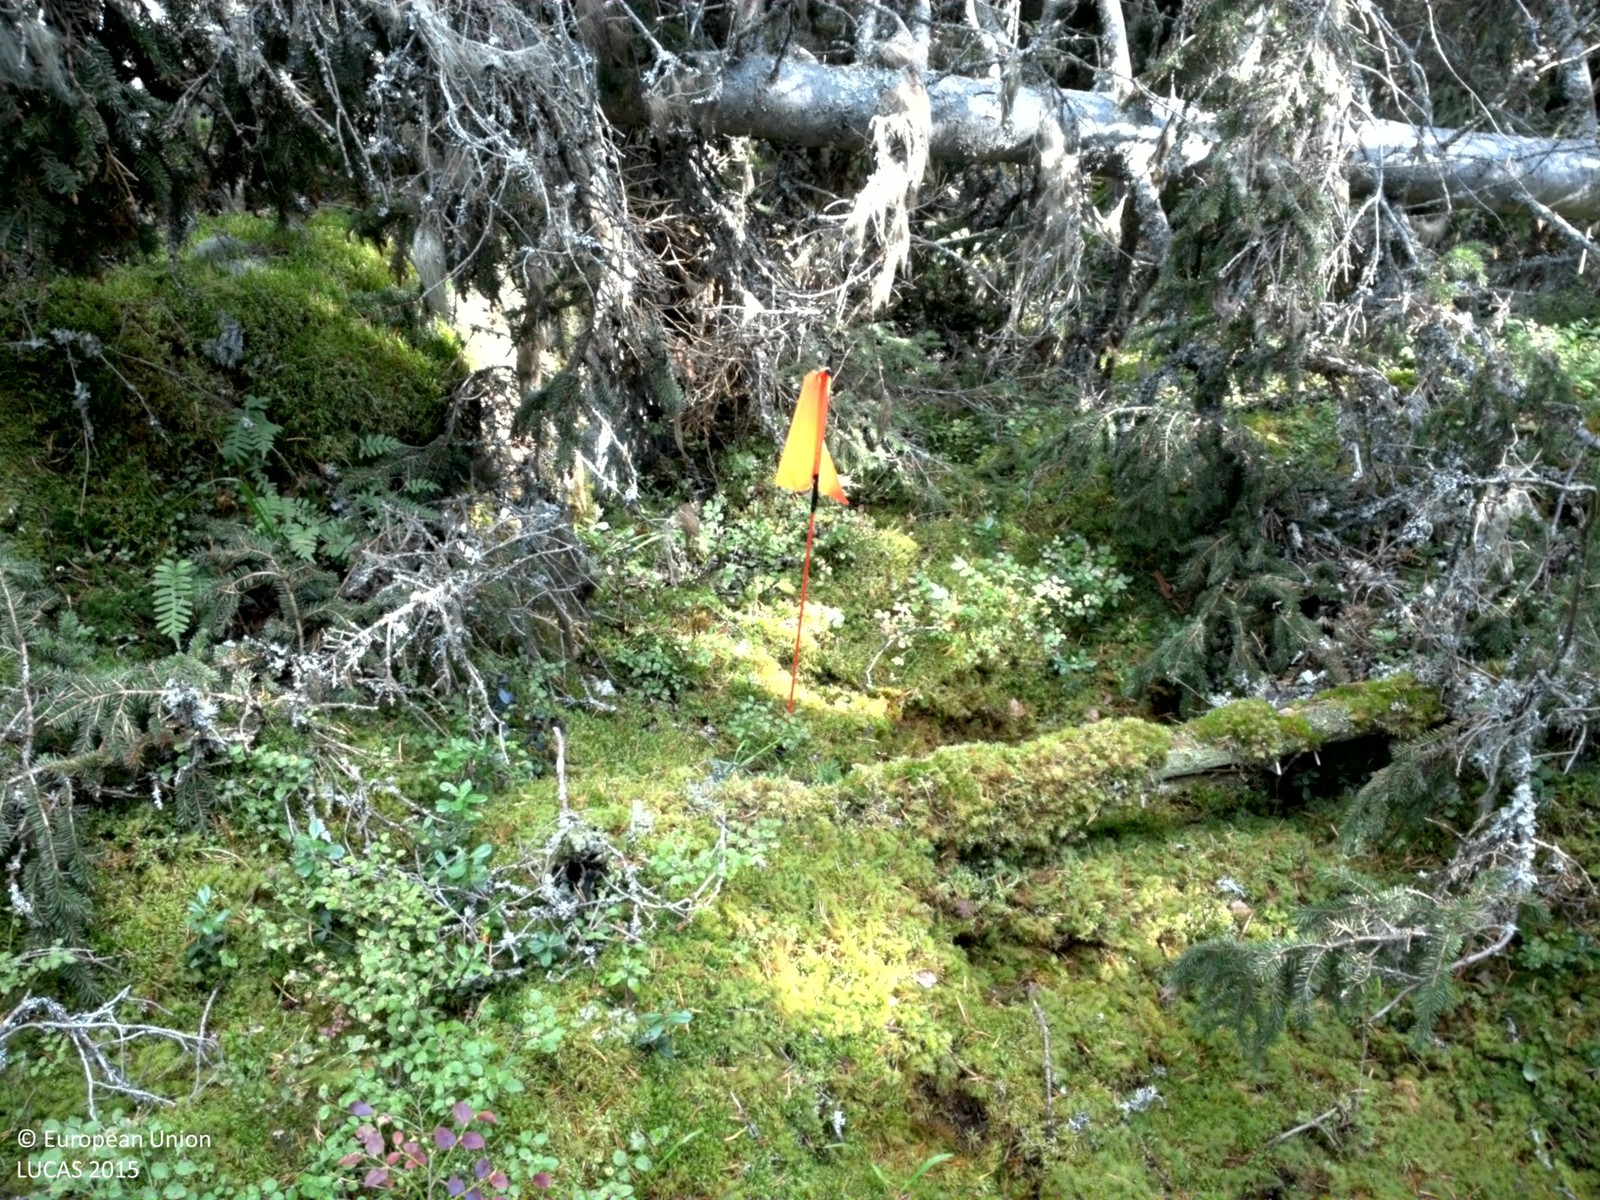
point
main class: Woodland
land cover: Spruce dominated coniferous woodland
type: boreal forest
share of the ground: > 75 %
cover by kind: coniferous forest trees 75 %, lichens and mosses 25 %
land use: Forestry
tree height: > 5 m
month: September
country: SE
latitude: 60.1543
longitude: 16.5652
